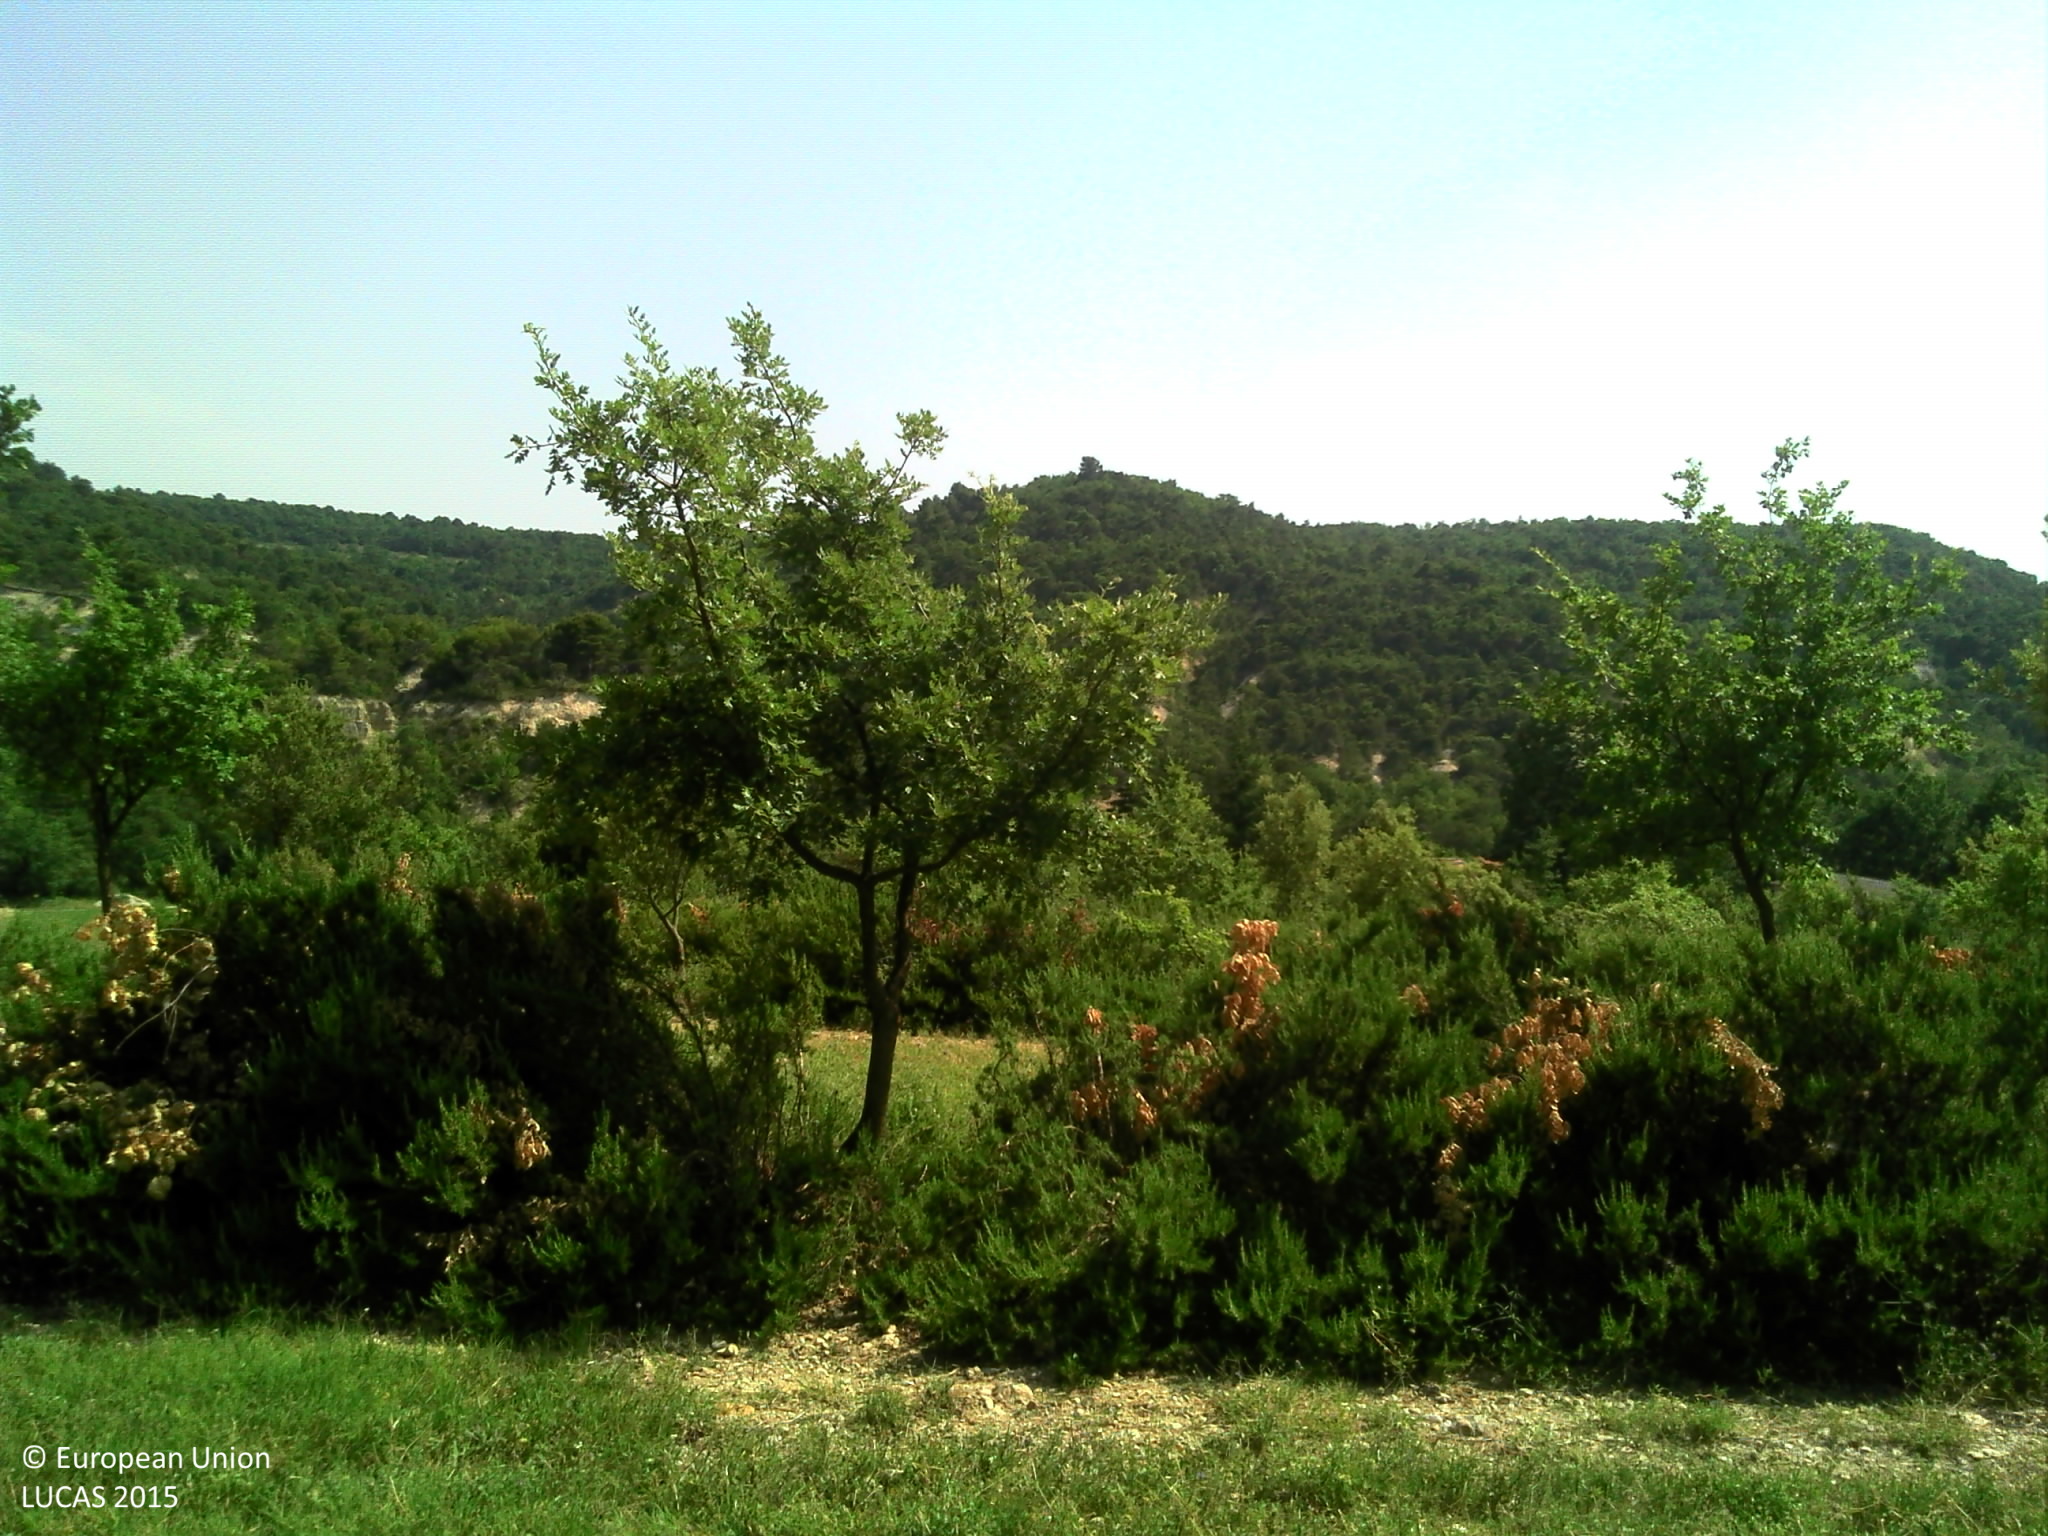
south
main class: Cropland
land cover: Other fresh vegetables
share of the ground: 25 - 50 %
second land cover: Spontaneously vegetated surfaces
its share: 50 - 75 %
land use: Agriculture (excluding fallow land and kitchen gardens)
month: July
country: FR
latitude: 44.3770
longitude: 5.0498
